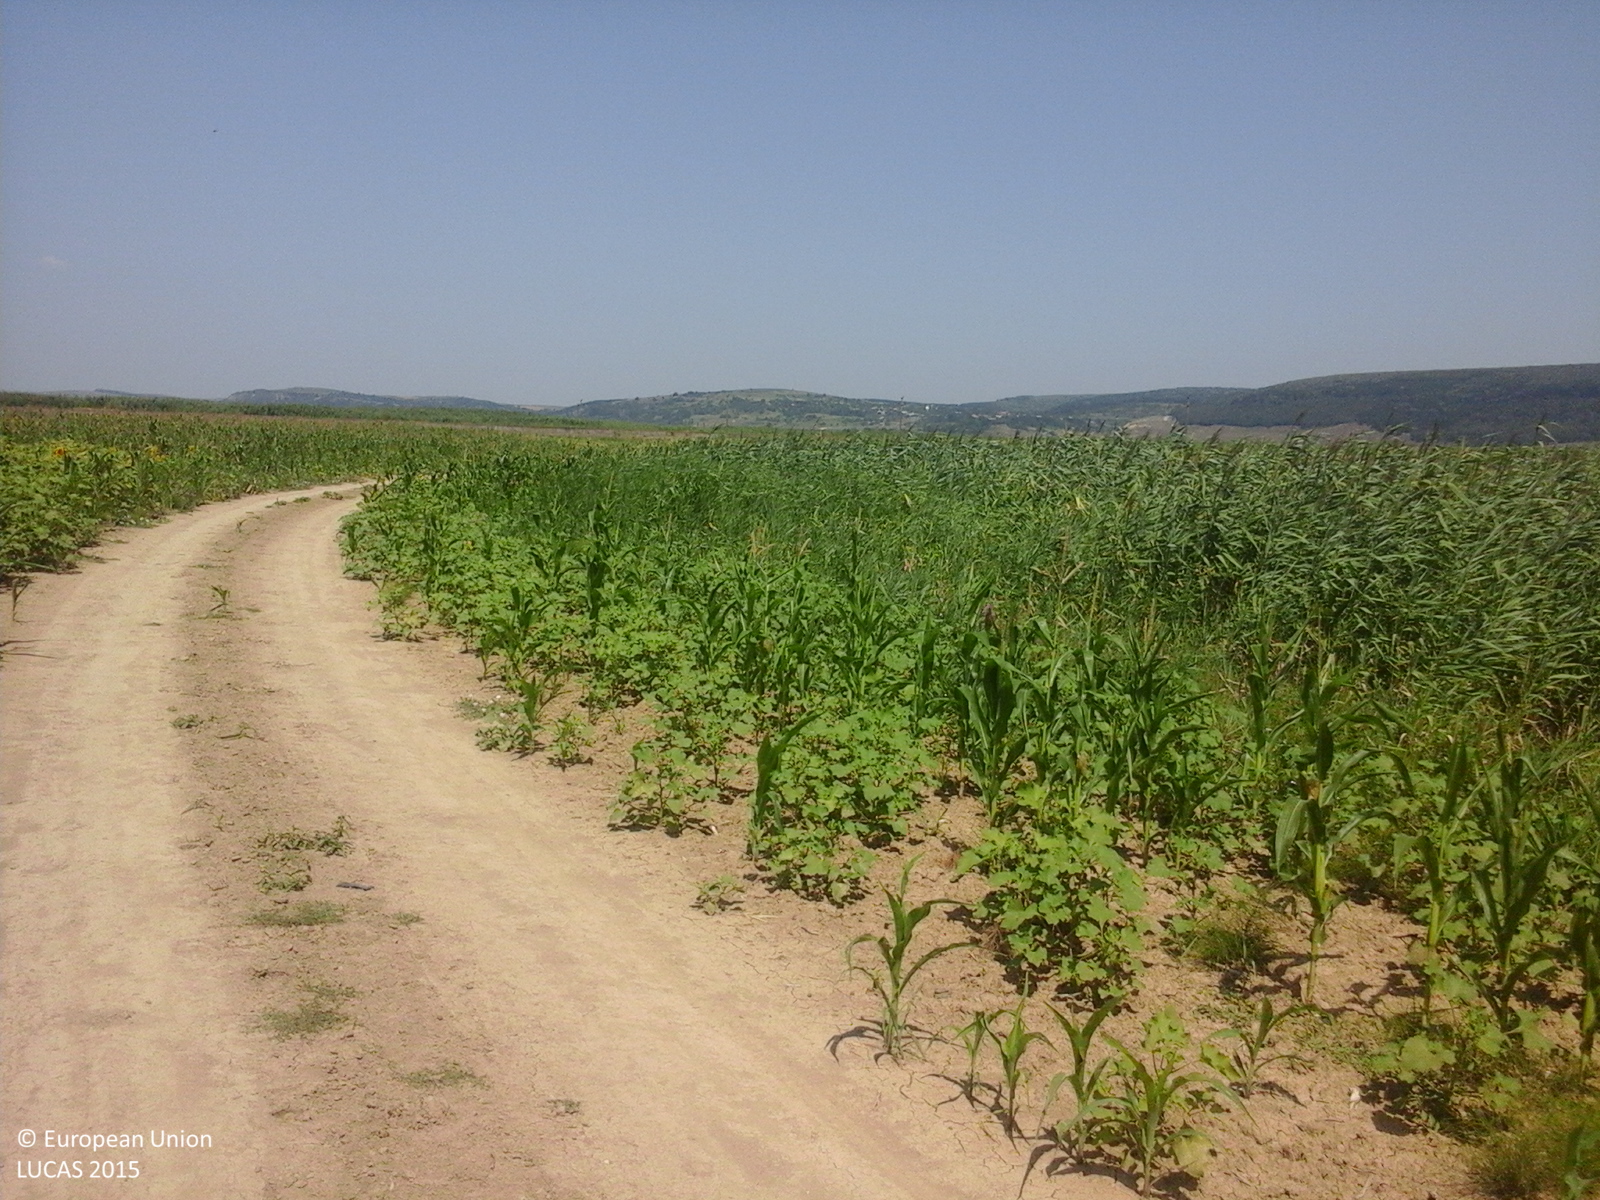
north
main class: Cropland
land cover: Maize
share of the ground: > 75 %
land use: Agriculture (excluding fallow land and kitchen gardens)
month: August
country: RO
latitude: 46.2700
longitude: 27.0817
